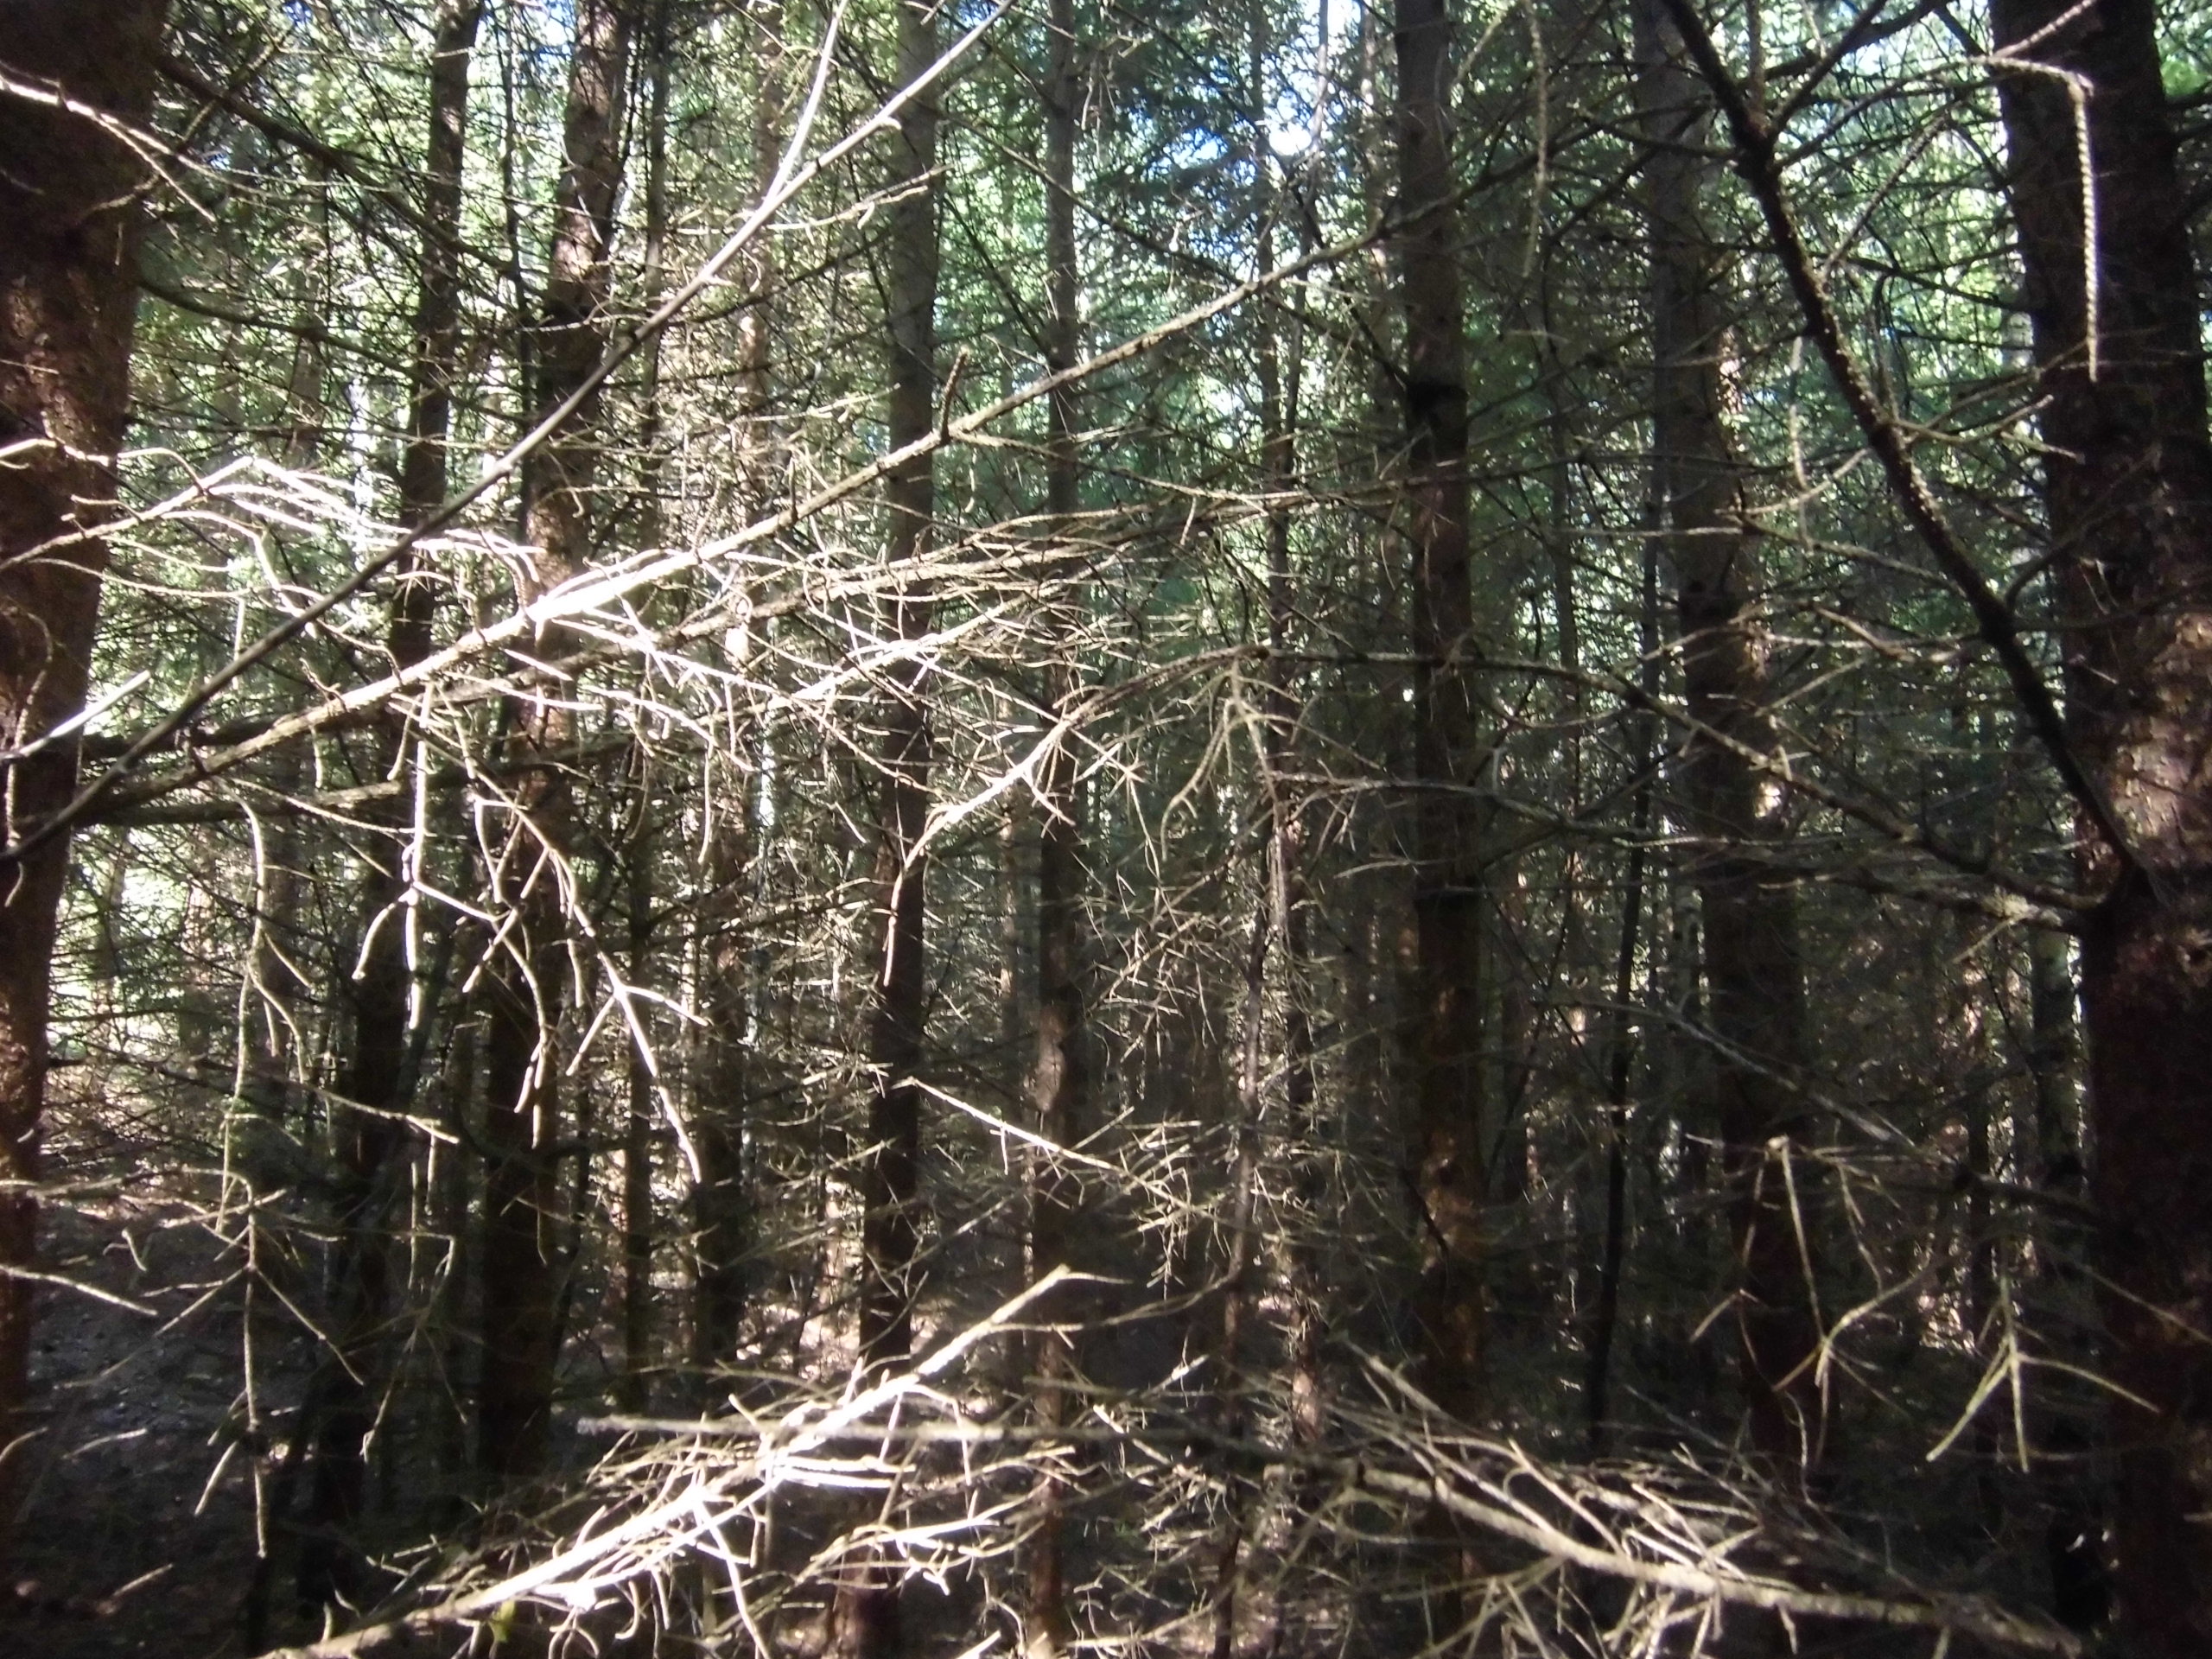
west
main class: Woodland
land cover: Spruce dominated coniferous woodland
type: boreal forest
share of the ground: > 75 %
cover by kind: coniferous forest trees 75 %, unconsolidated bare surface 15 %, broadleaved forest trees 5 %, lichens and mosses 5 %
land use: Forestry
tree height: > 5 m
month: July
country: SE
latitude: 57.3153
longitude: 15.4597
